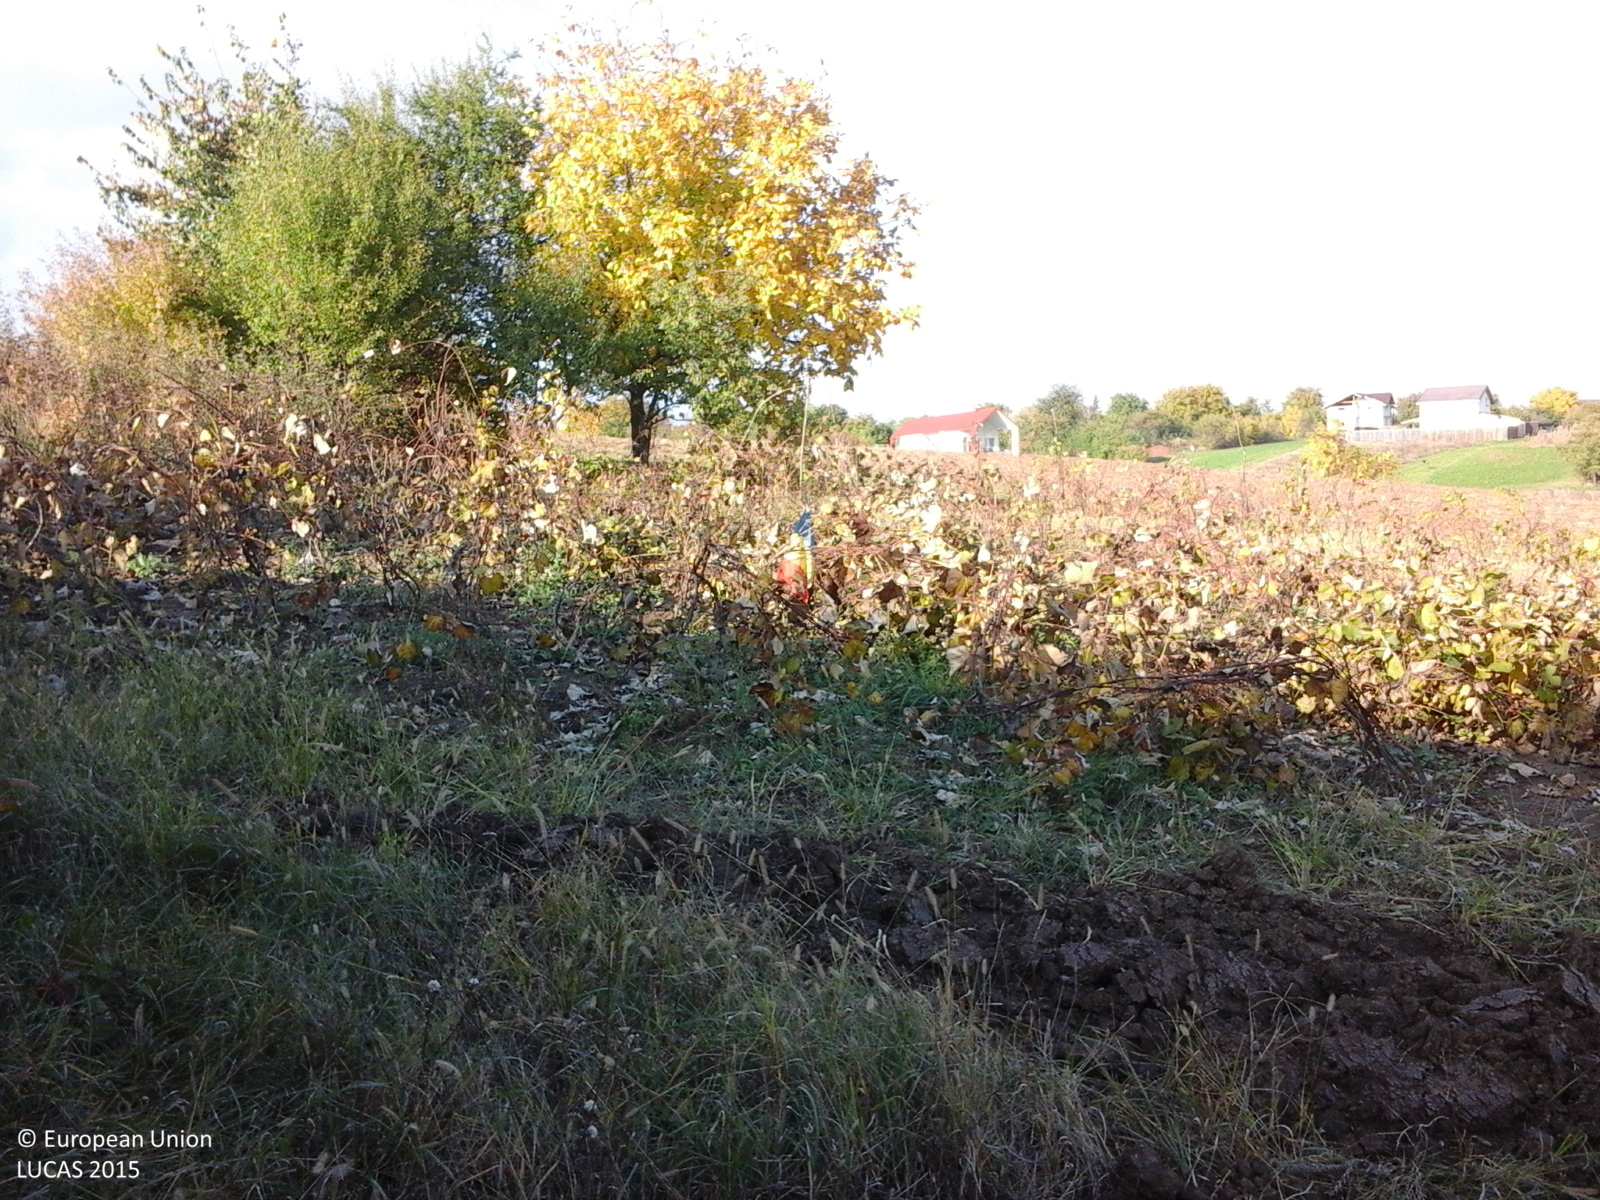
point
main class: Cropland
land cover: Vineyards
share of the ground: > 75 %
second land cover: Grassland without tree/shrub cover
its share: > 75 %
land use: Agriculture (excluding fallow land and kitchen gardens)
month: October
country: RO
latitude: 44.6761
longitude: 26.0129
